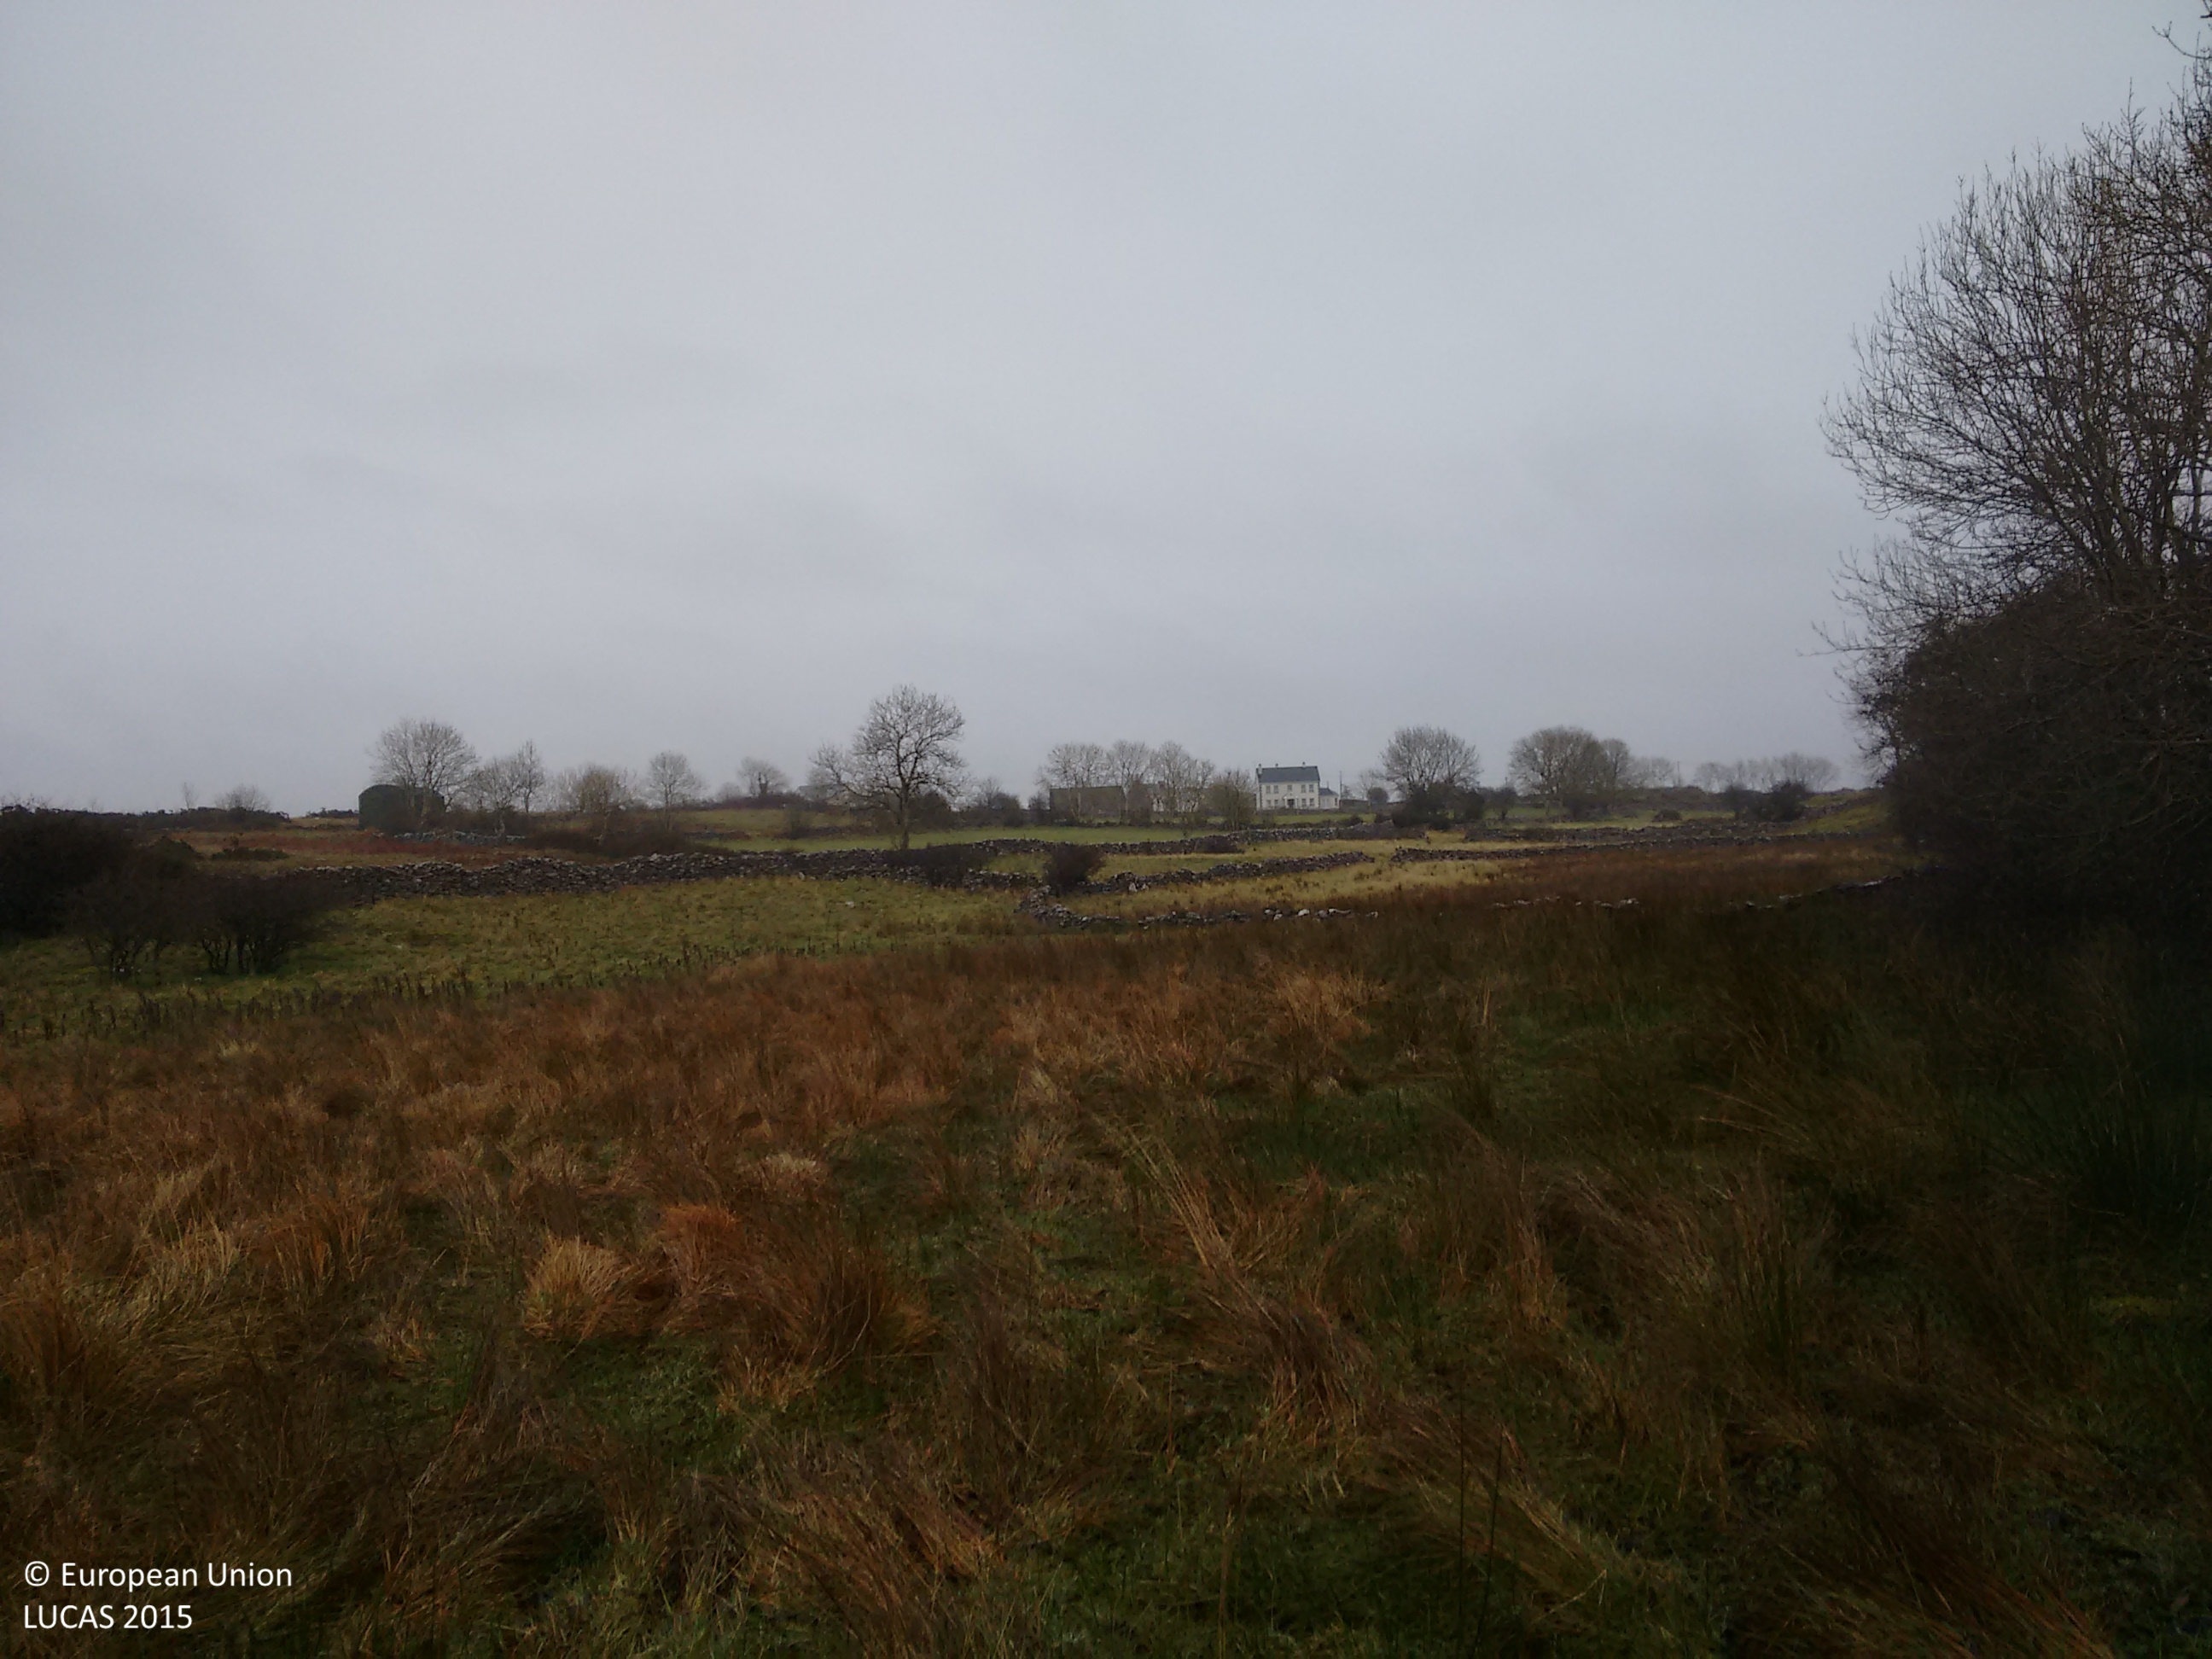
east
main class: Grassland
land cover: Grassland without tree/shrub cover
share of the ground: > 75 %
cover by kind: herbaceous plants 100 %
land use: Agriculture (excluding fallow land and kitchen gardens)
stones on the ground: < 10 %
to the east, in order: Grassland without tree/shrub cover; Dry stone walls; Grassland without tree/shrub cover; Dry stone walls; Grassland without tree/shrub cover; Dry stone walls; Grassland without tree/shrub cover; Dry stone walls; Abandoned hedges; Grassland without tree/shrub cover
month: November
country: IE
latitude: 54.5469
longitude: -8.1253
